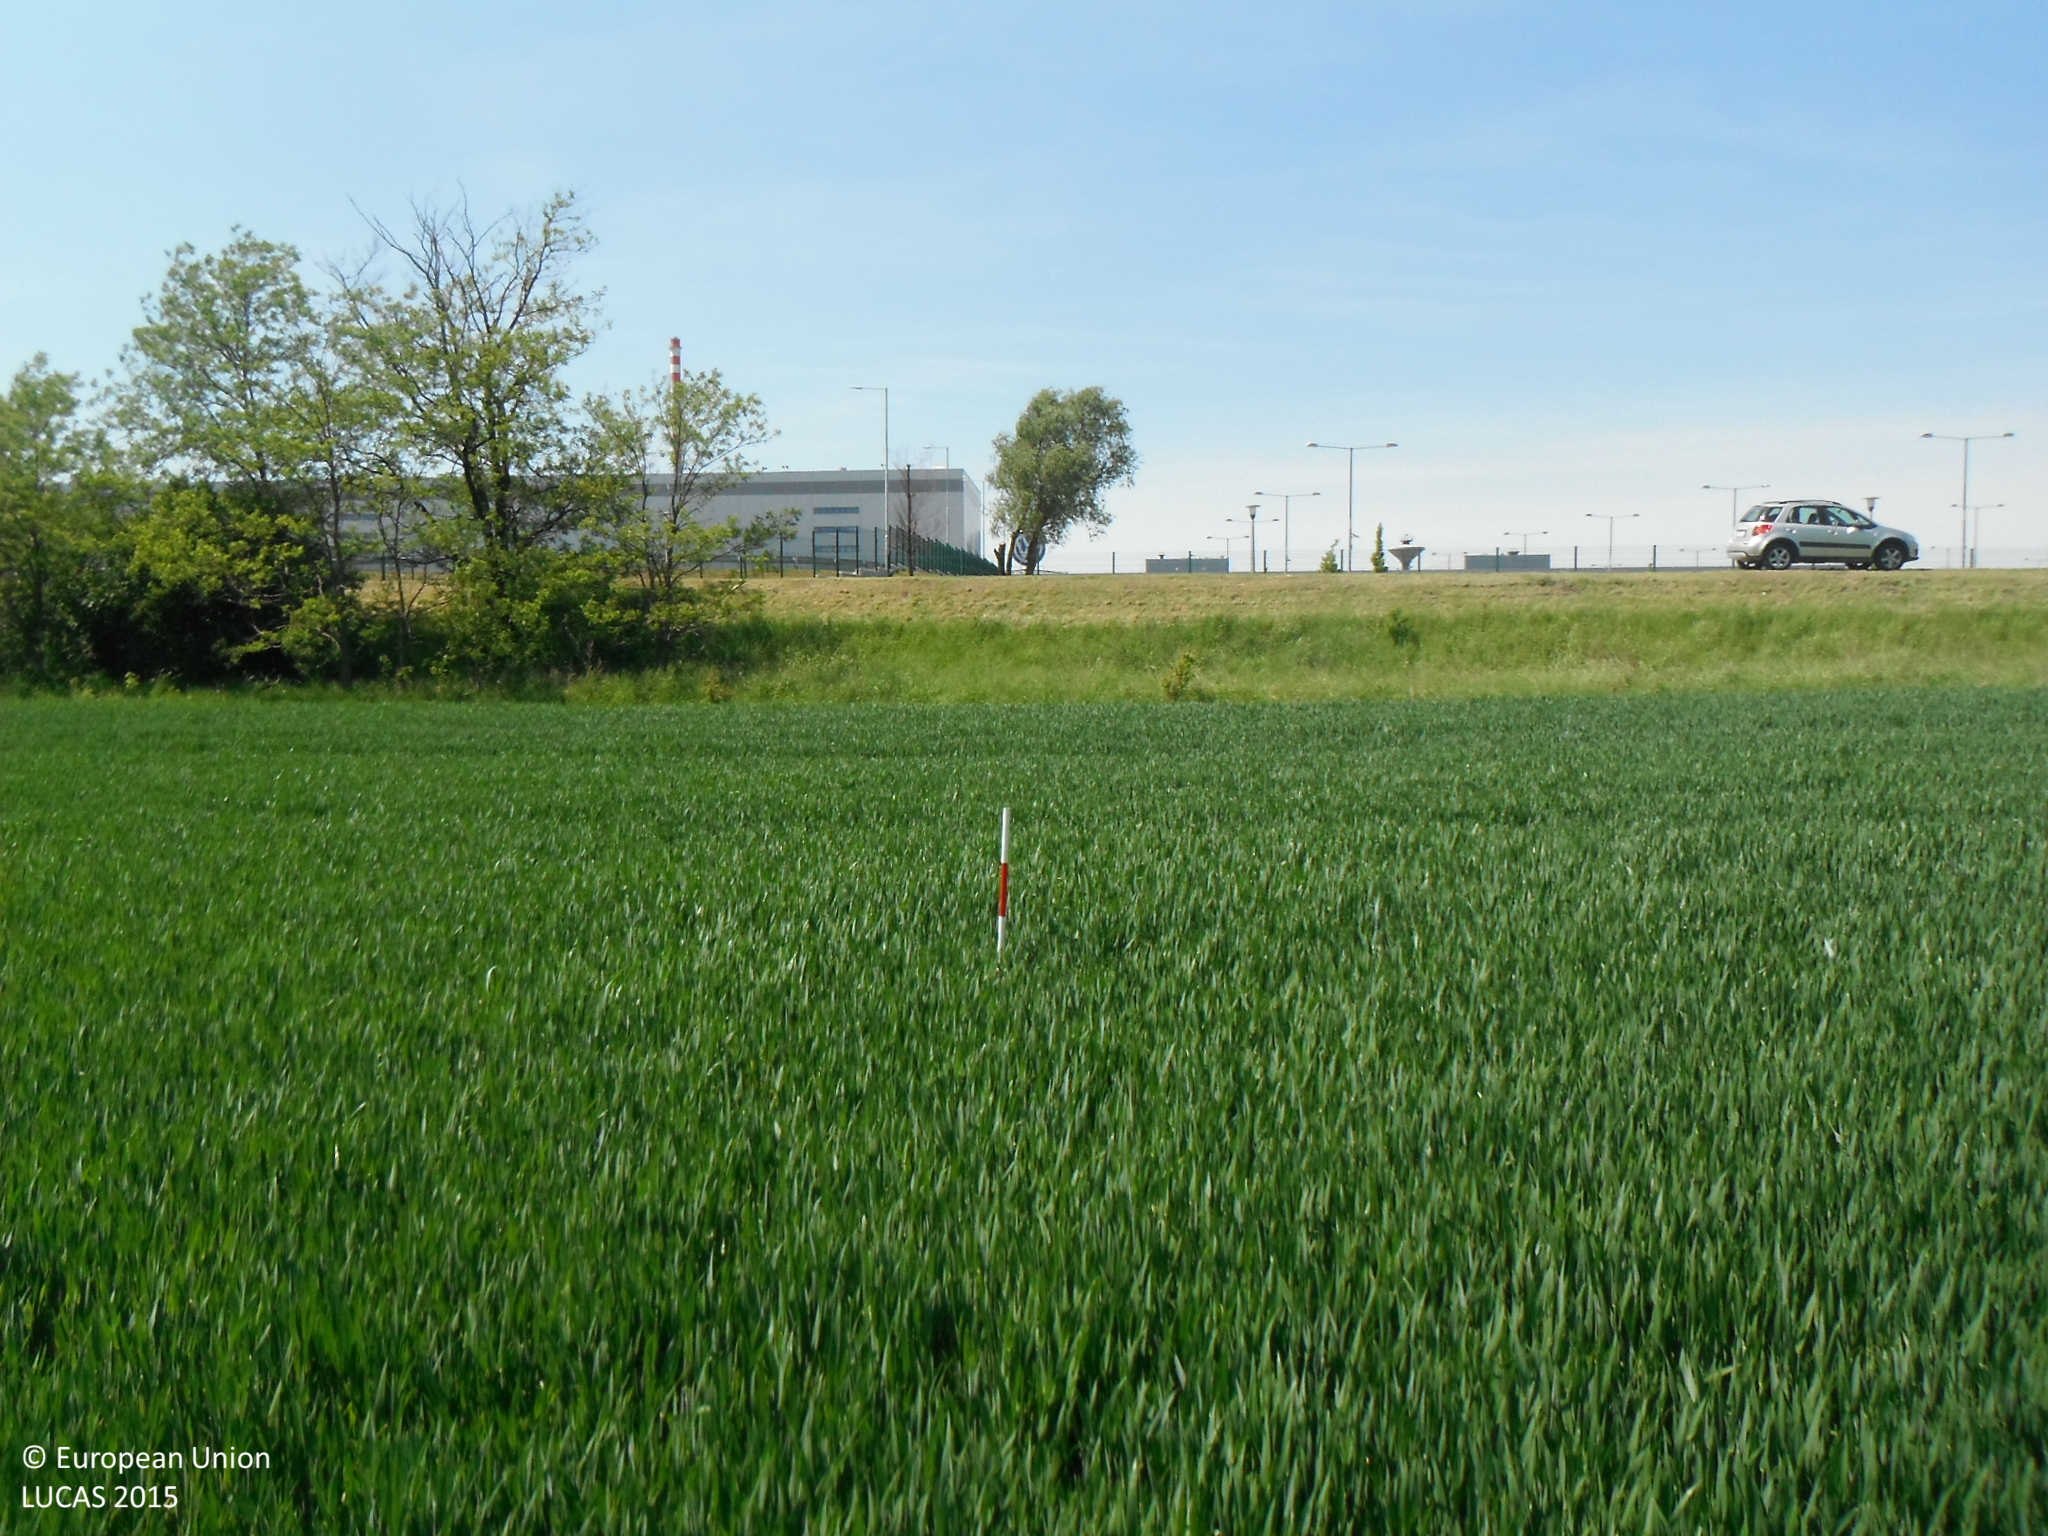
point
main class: Cropland
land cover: Common wheat
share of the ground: > 75 %
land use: Agriculture (excluding fallow land and kitchen gardens)
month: May
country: SK
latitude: 48.2360
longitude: 16.9954
